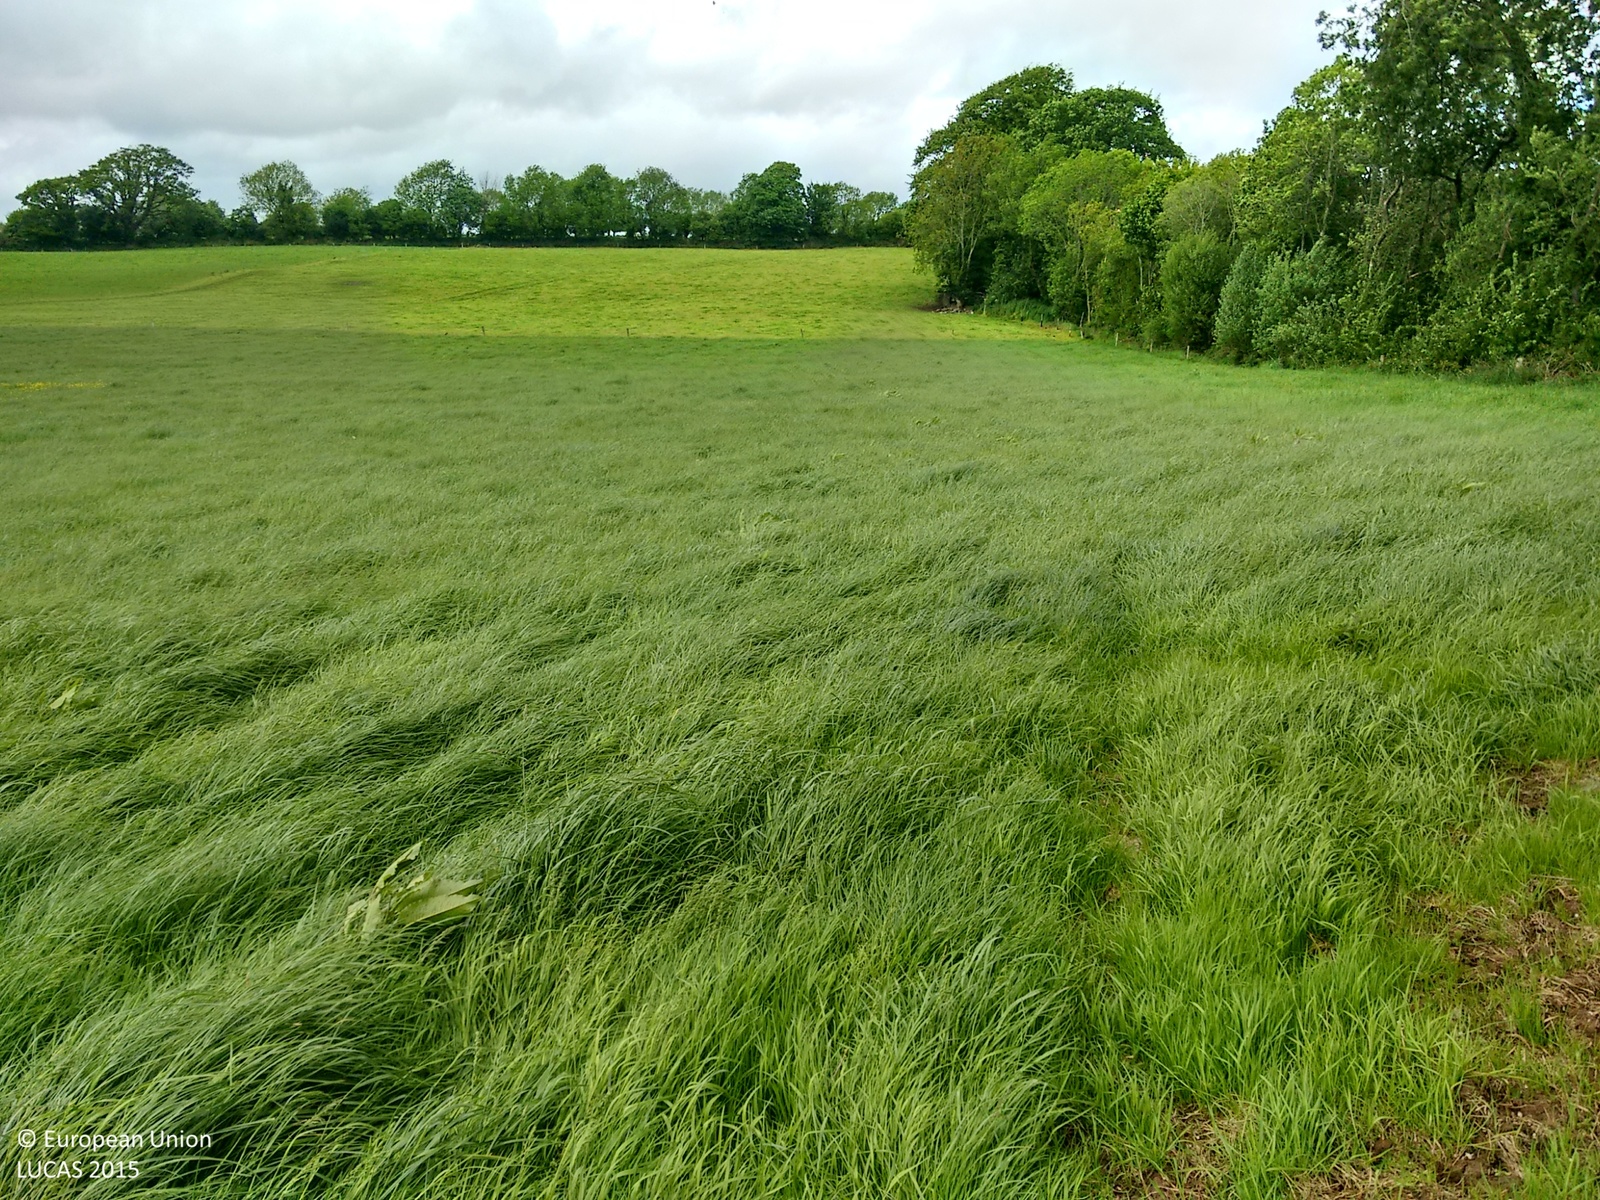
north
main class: Grassland
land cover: Grassland without tree/shrub cover
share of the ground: > 75 %
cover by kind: herbaceous plants 100 %
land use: Agriculture (excluding fallow land and kitchen gardens)
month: June
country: IE
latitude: 51.9093
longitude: -8.7972
